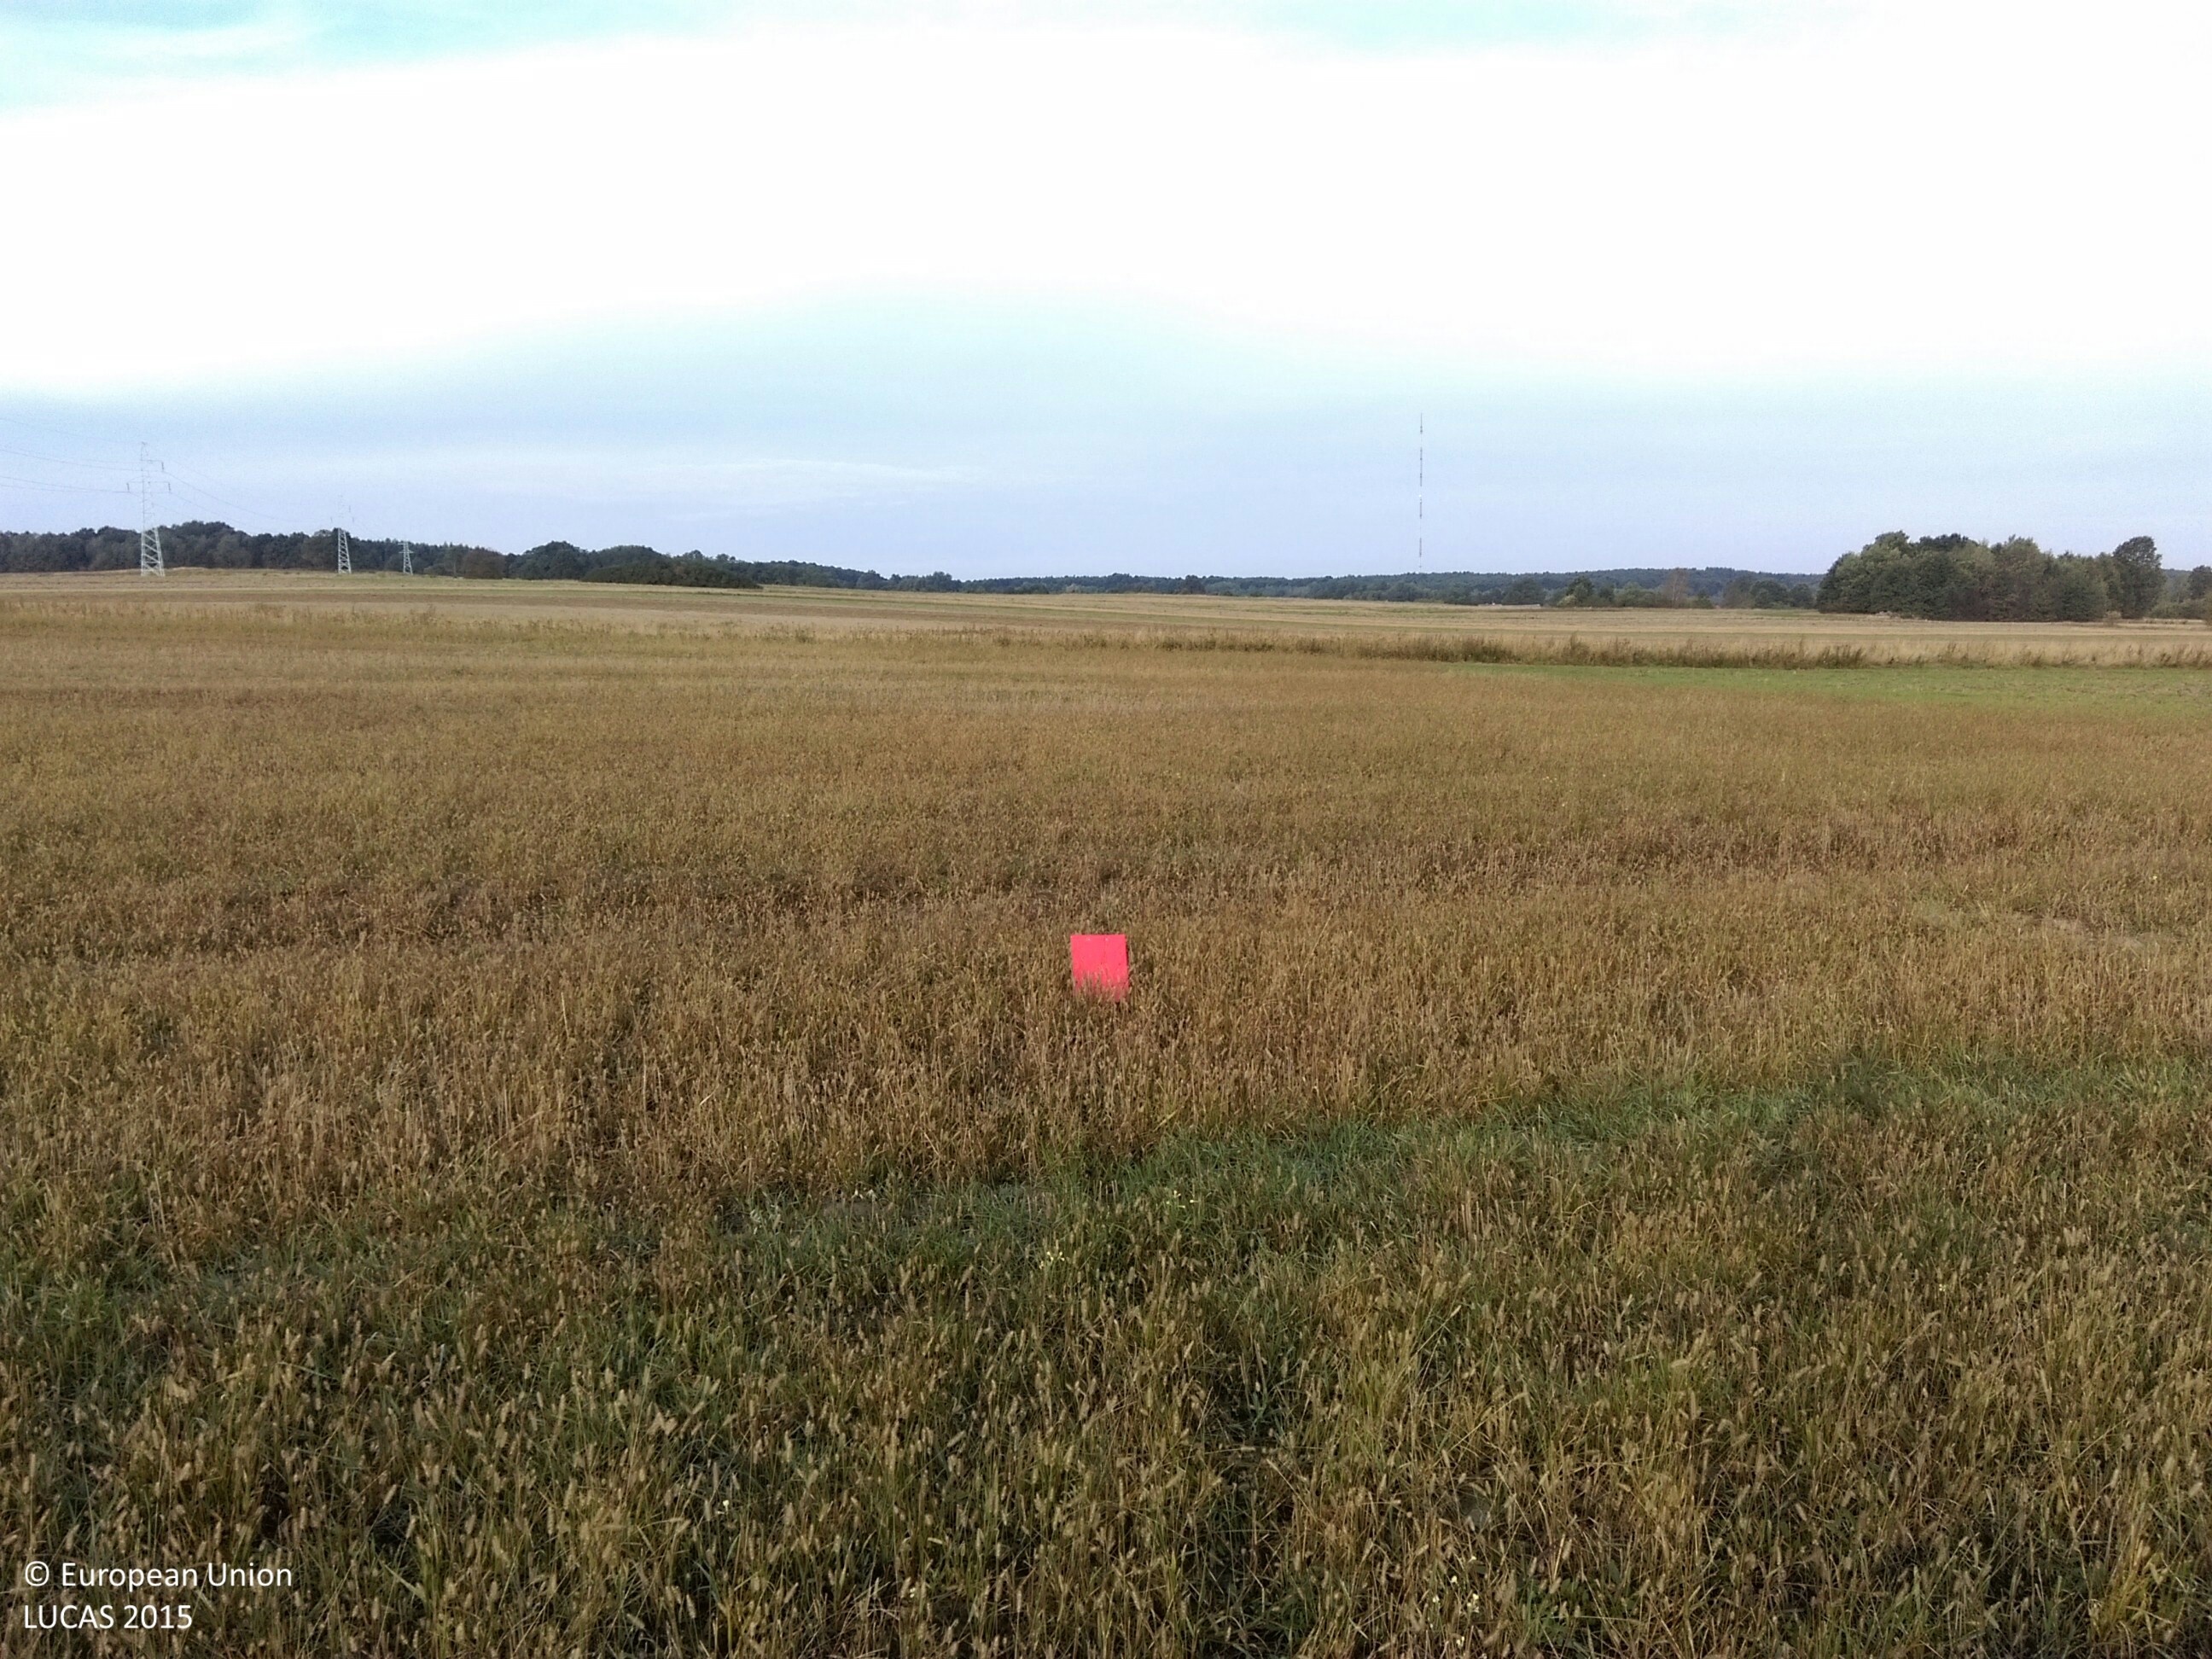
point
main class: Grassland
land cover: Grassland without tree/shrub cover
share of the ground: > 75 %
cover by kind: herbaceous plants 80 %, unconsolidated bare surface 20 %
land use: Agriculture (excluding fallow land and kitchen gardens)
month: September
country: PL
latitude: 51.7445
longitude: 15.5224
